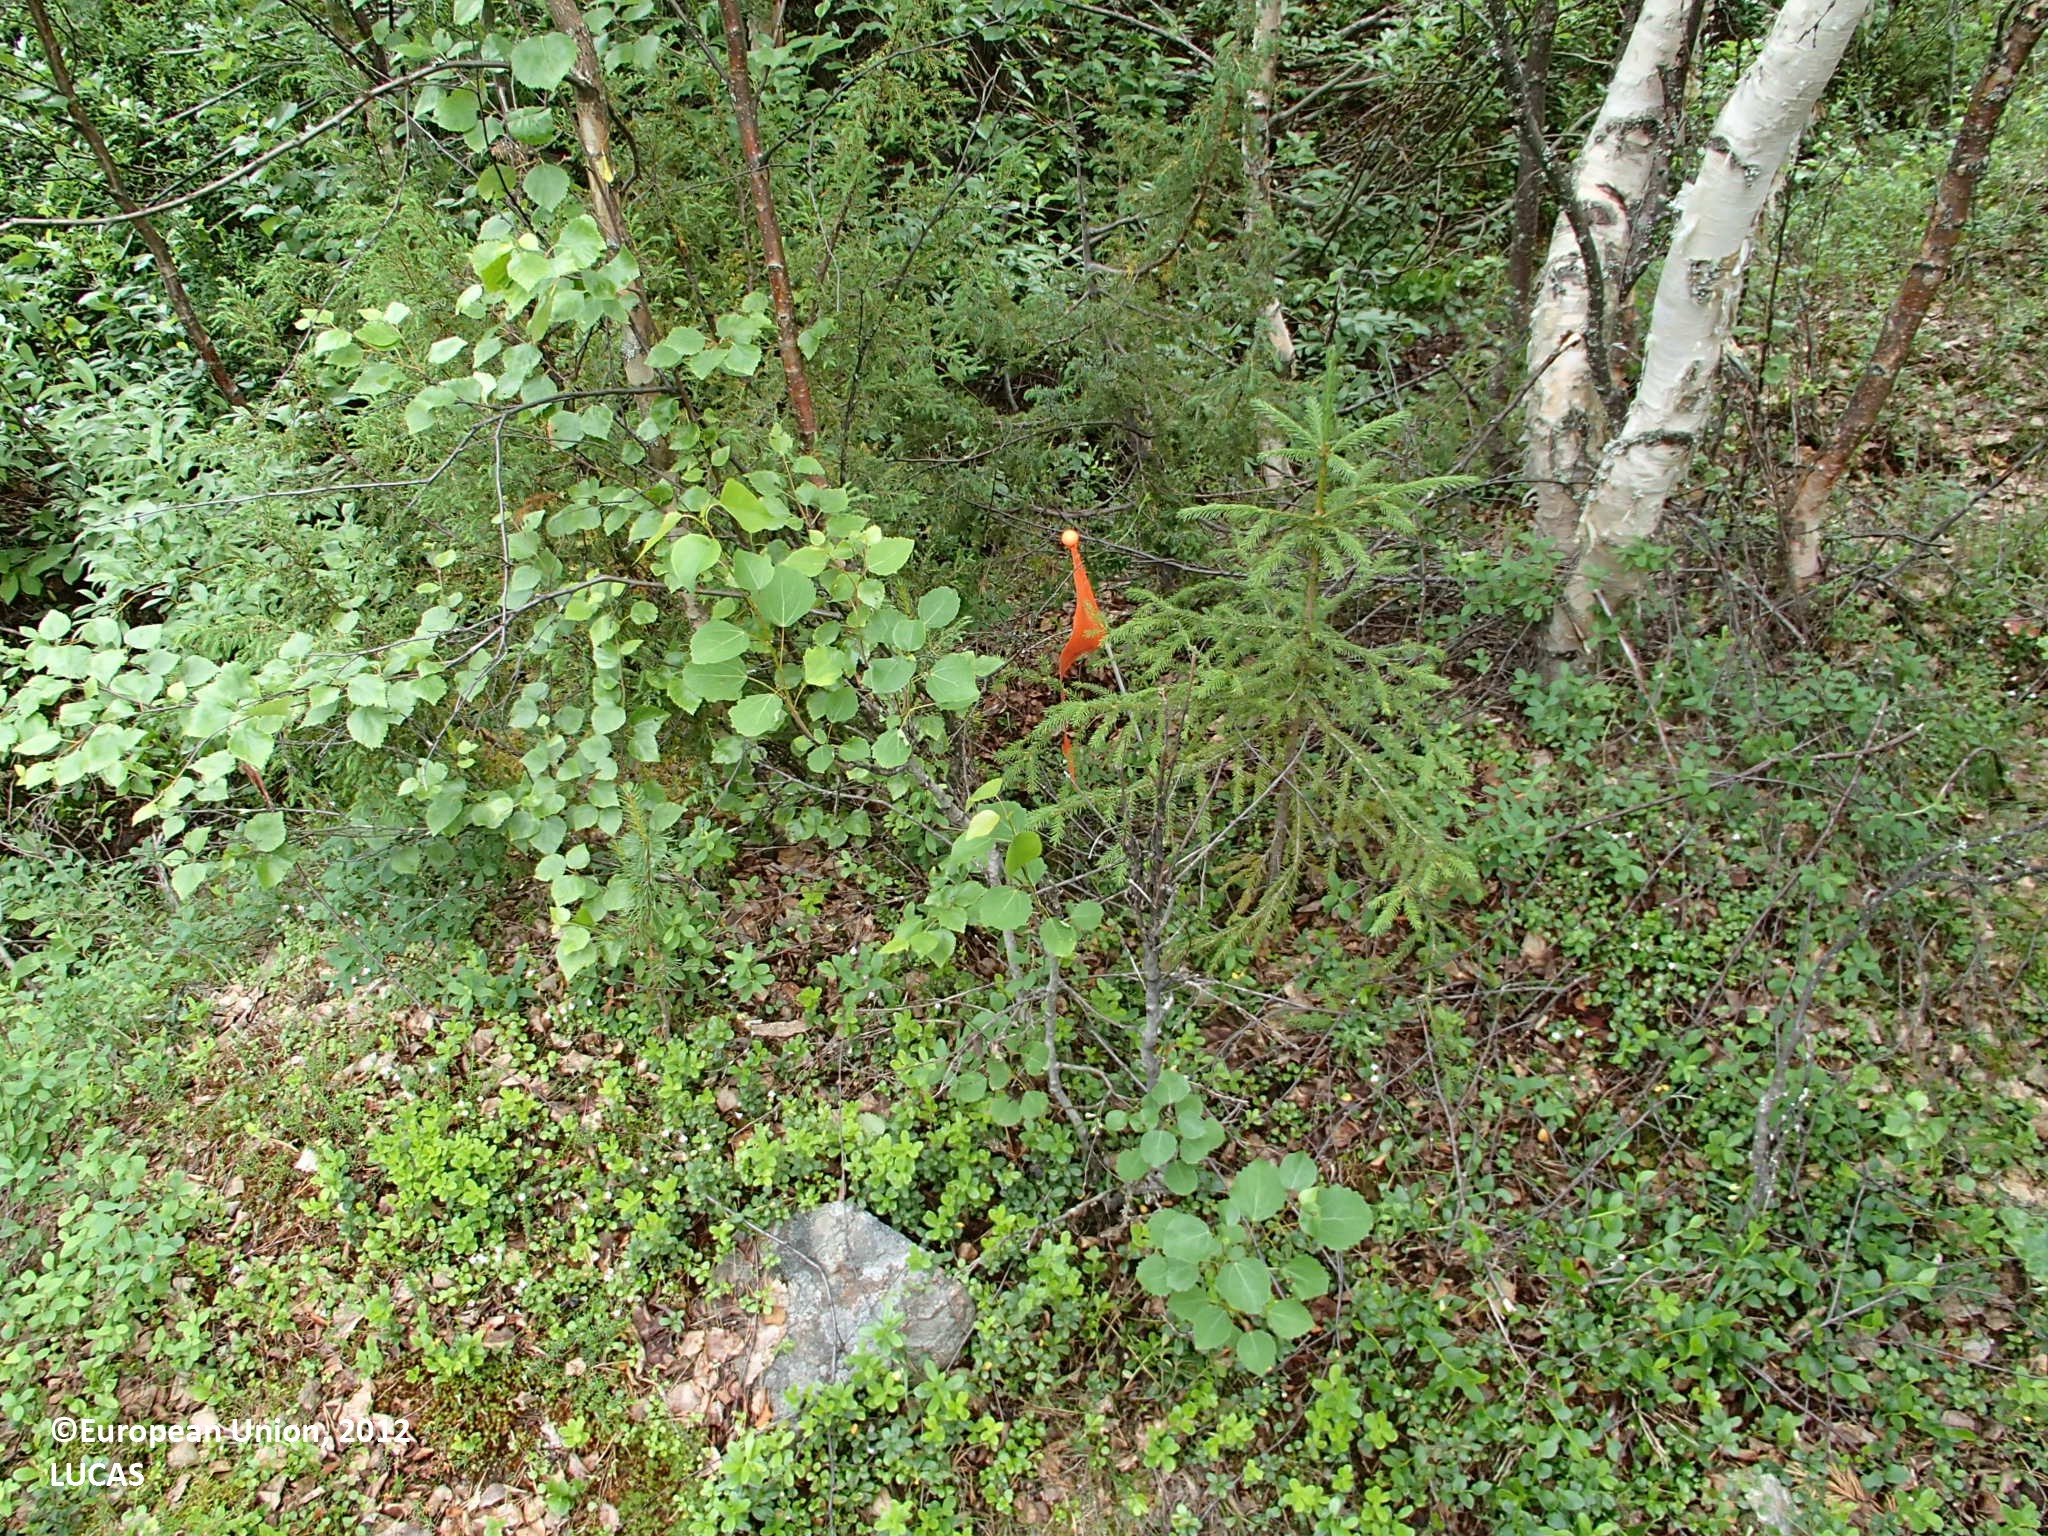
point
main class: Woodland
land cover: Other mixed woodland
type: boreal forest
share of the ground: > 75 %
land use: Forestry
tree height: > 5 m
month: July
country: FI
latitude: 66.9873
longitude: 25.4366
